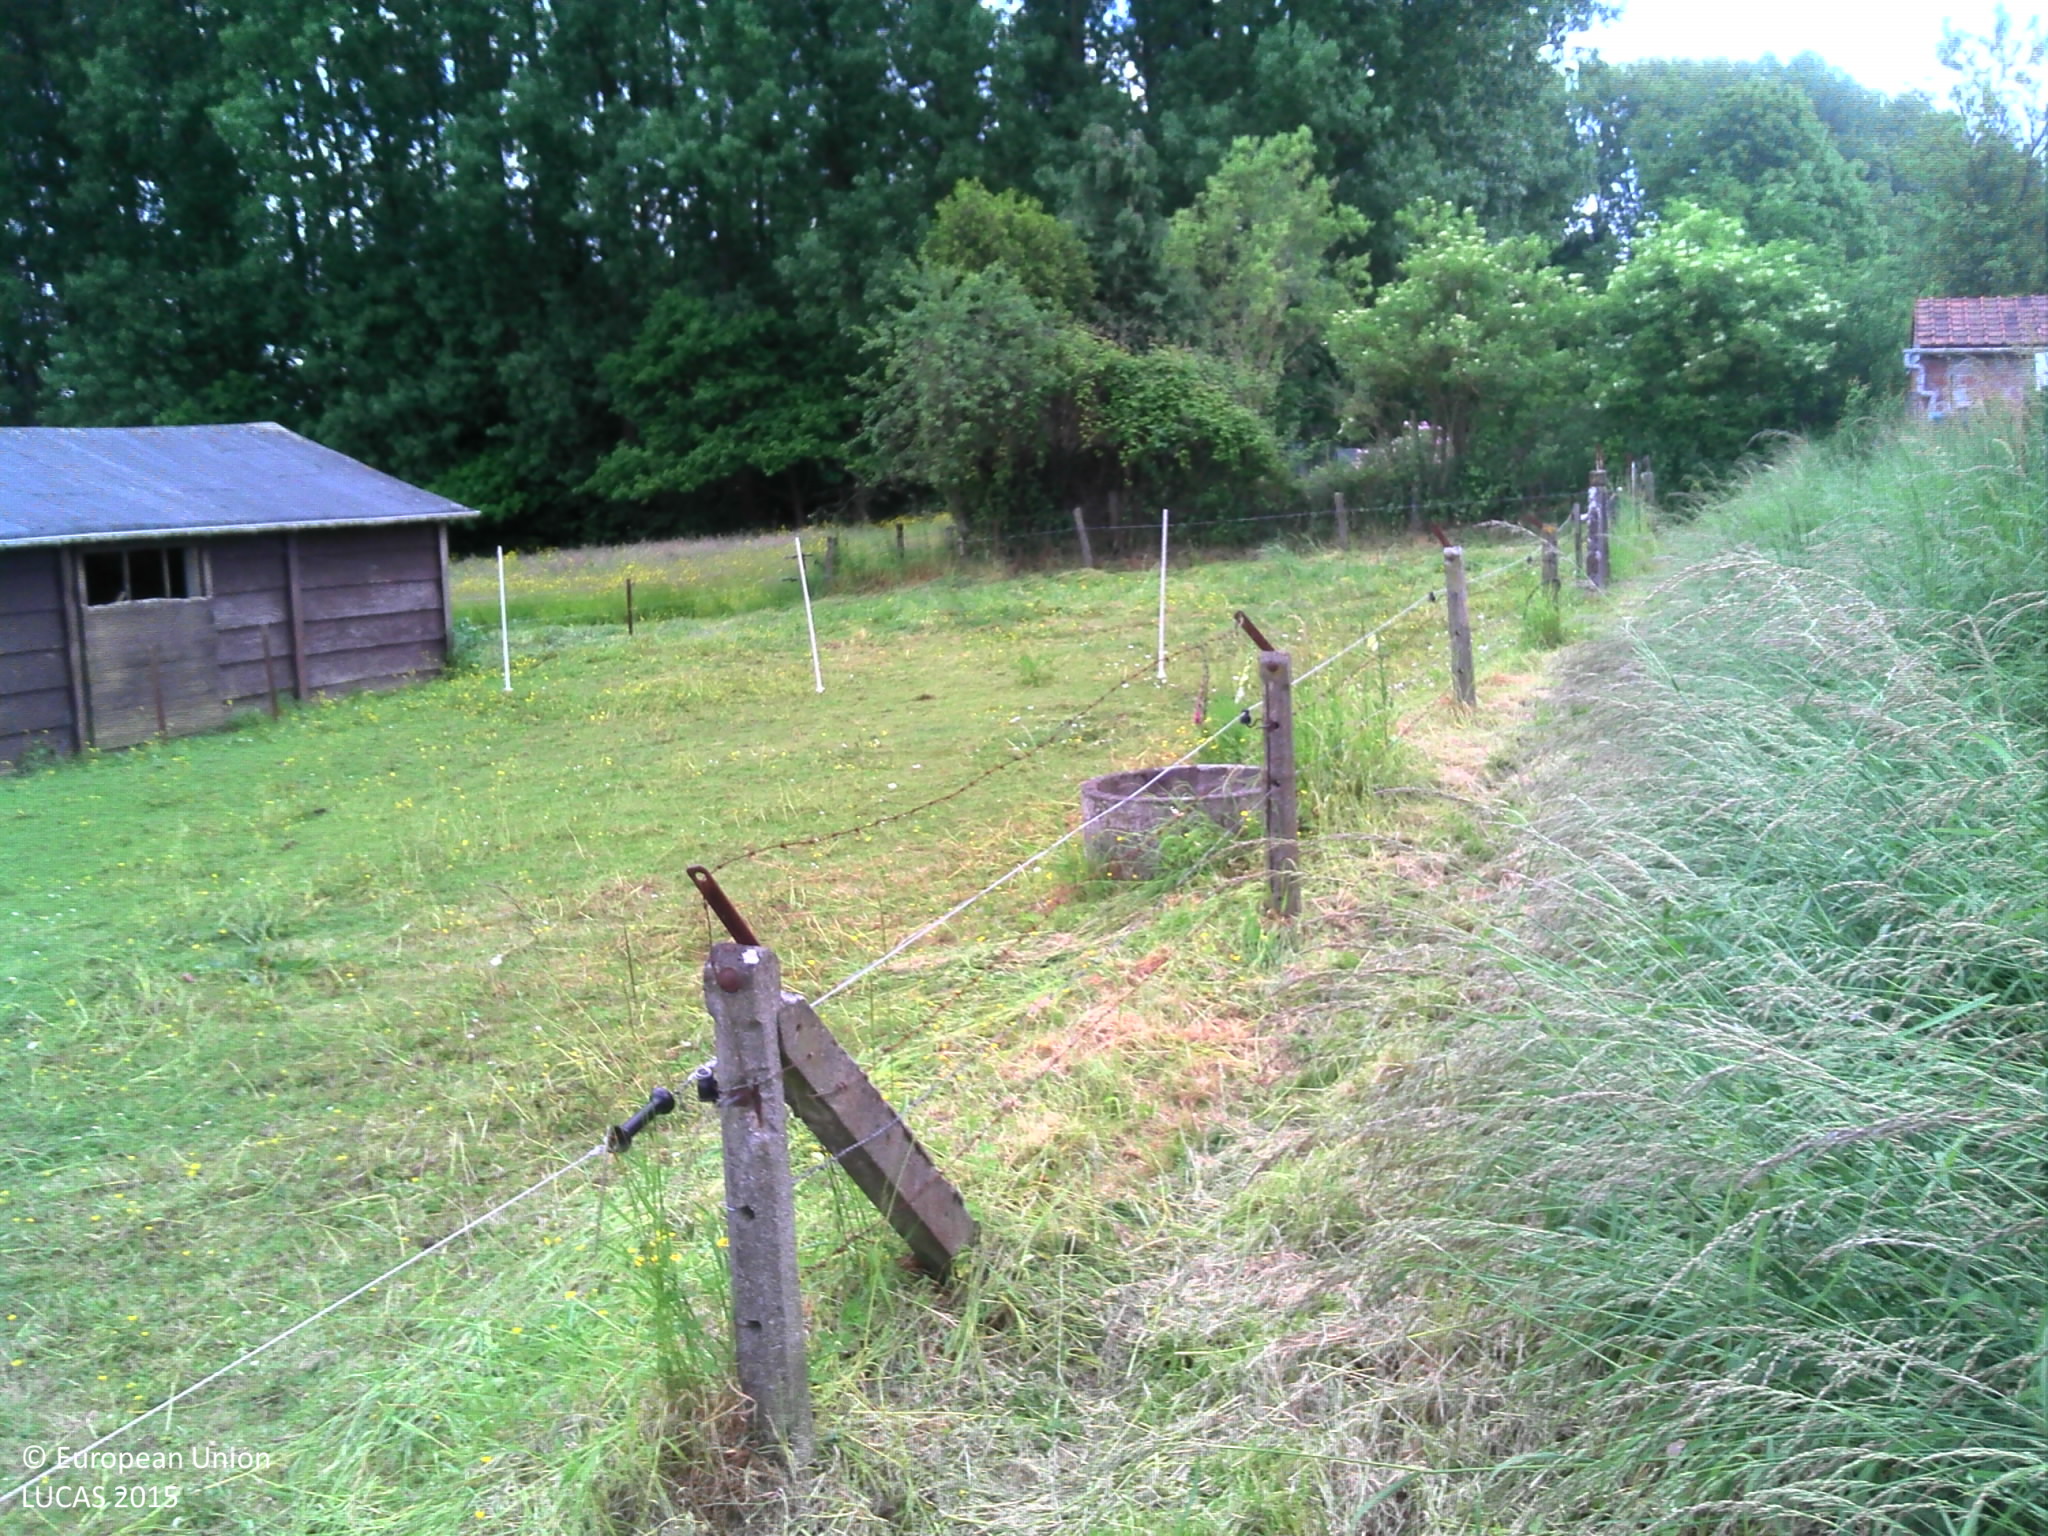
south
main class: Grassland
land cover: Grassland with sparse tree/shrub cover
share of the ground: > 75 %
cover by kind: herbaceous plants 95 %, broadleaved forest trees 5 %
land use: Residential
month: June
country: BE
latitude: 50.7594
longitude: 3.8837
